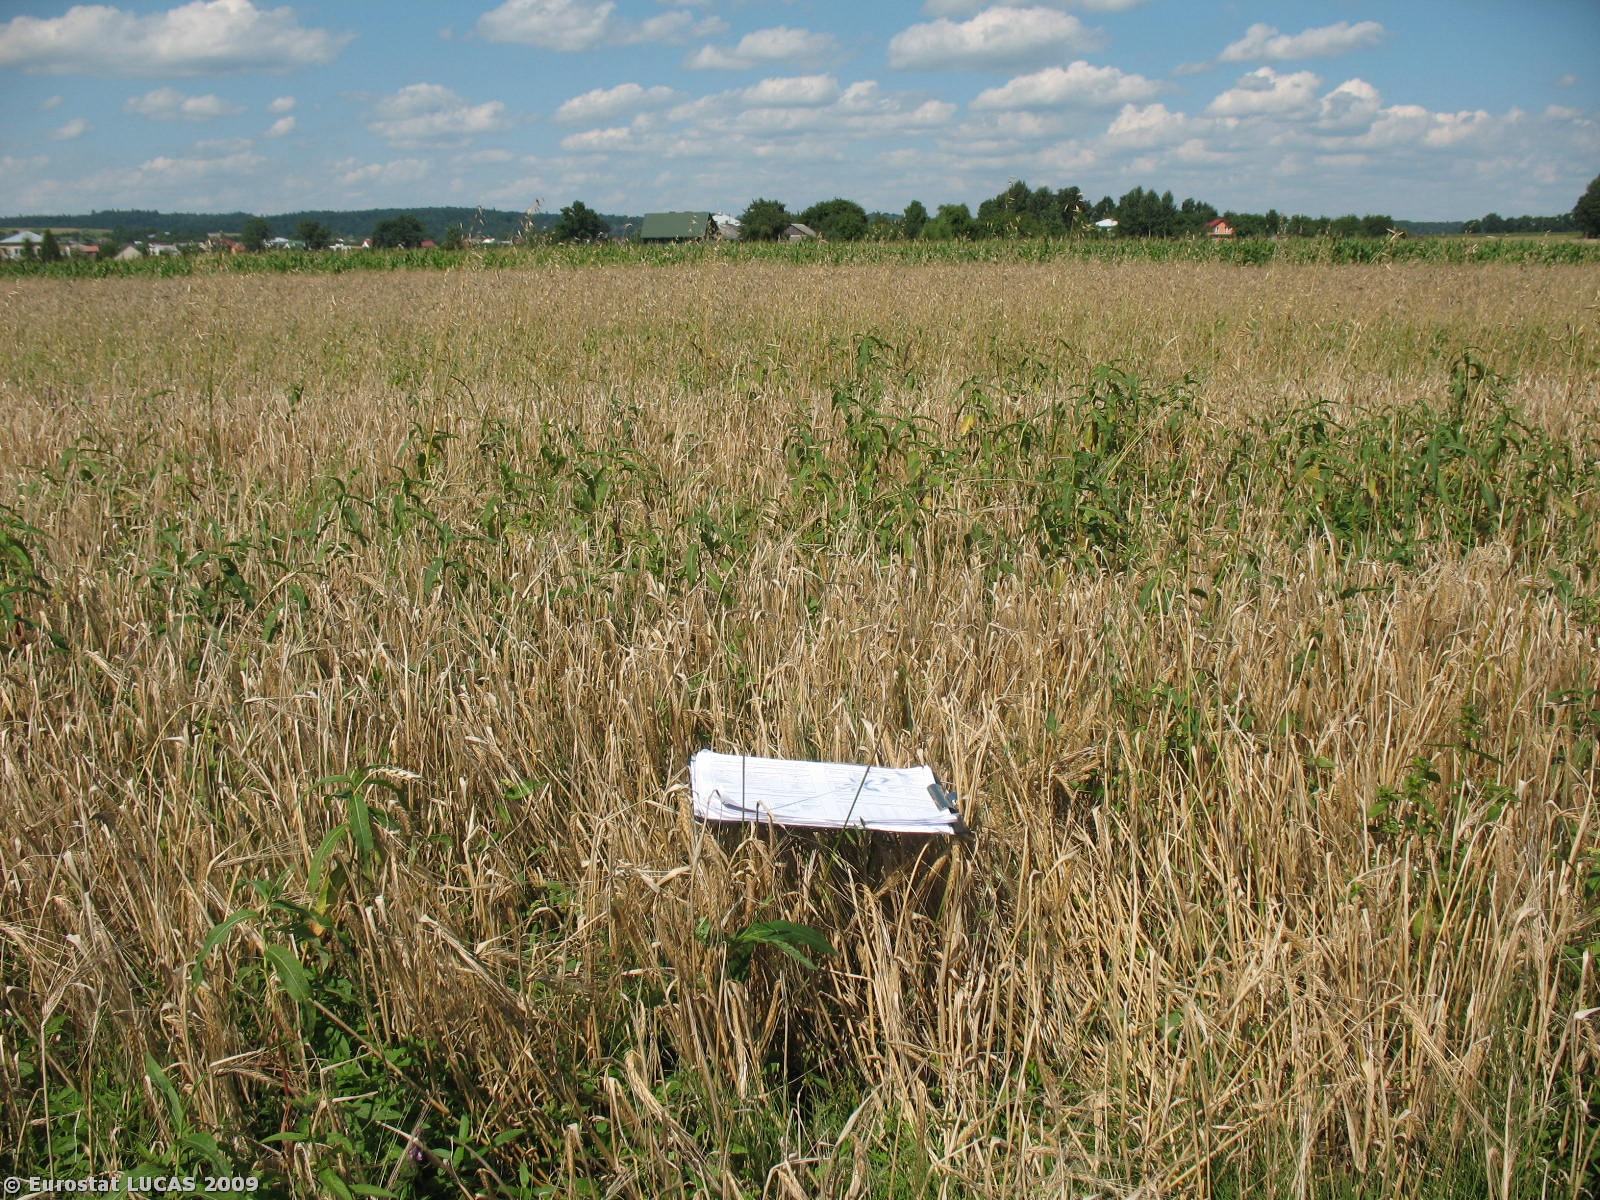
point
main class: Cropland
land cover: Barley
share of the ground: > 75 %
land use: Agriculture (excluding fallow land and kitchen gardens)
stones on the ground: < 10 %
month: July
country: PL
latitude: 49.6408
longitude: 21.9796
